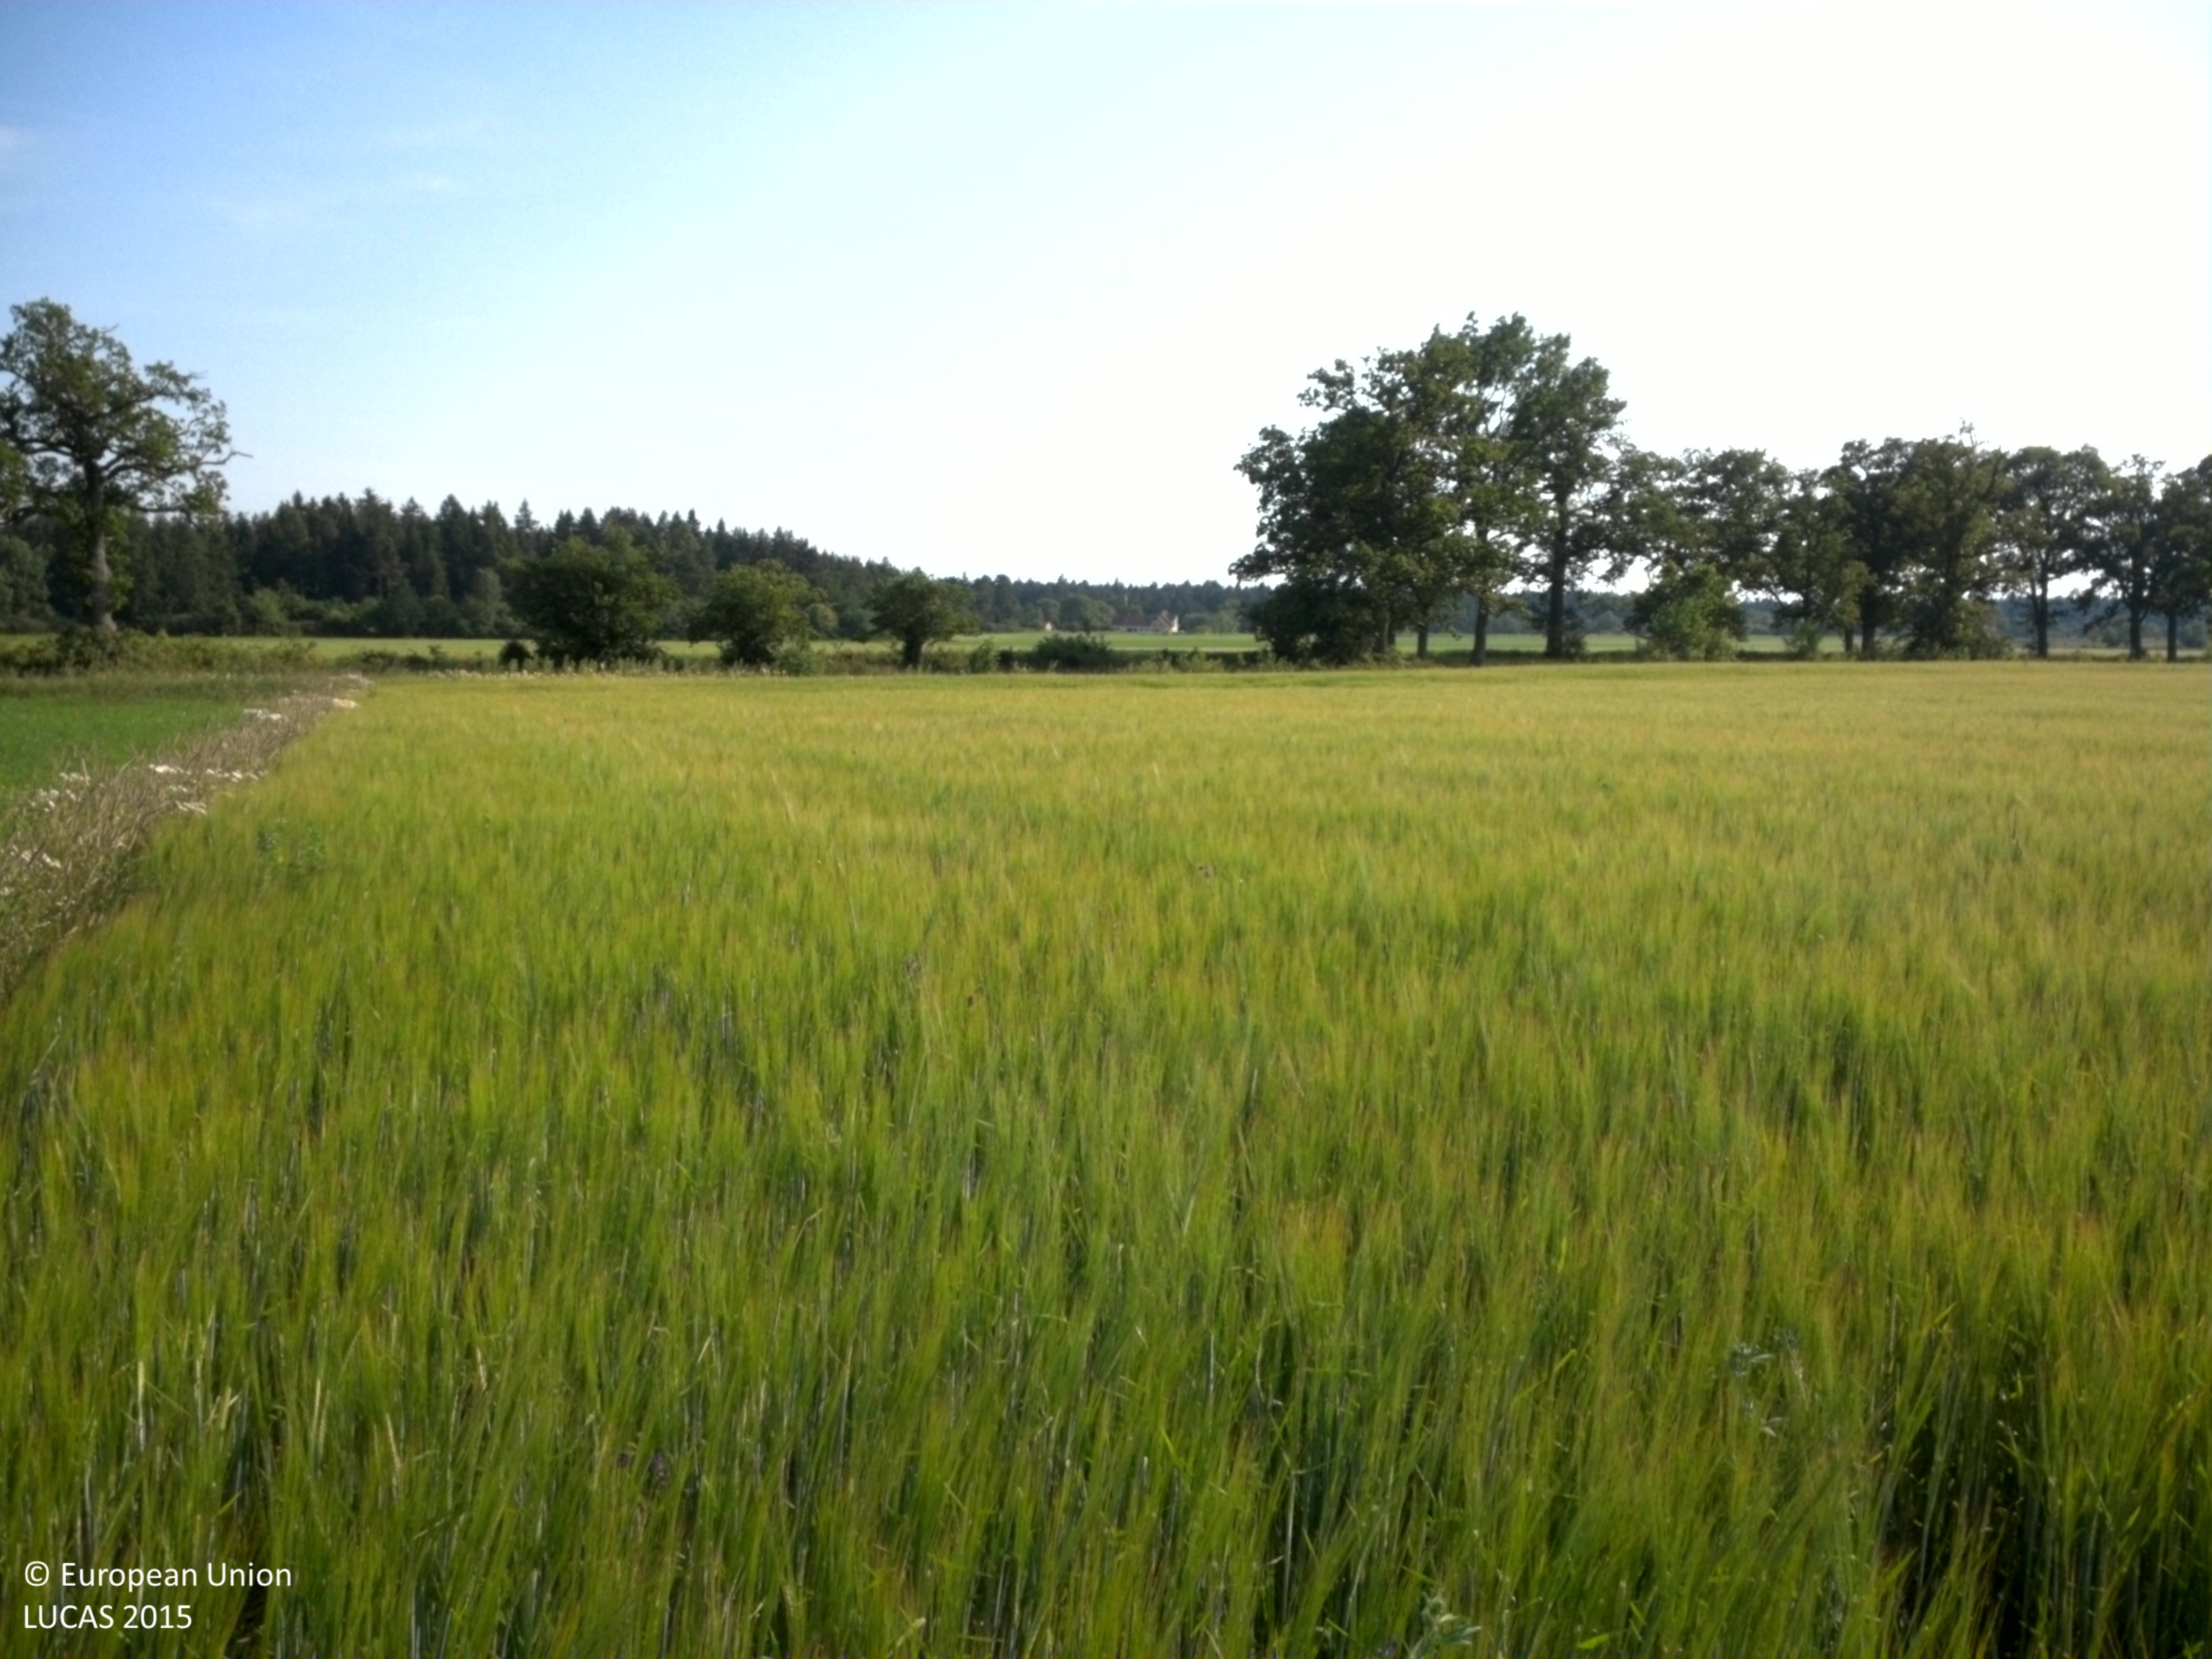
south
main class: Cropland
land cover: Barley
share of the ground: > 75 %
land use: Agriculture (excluding fallow land and kitchen gardens)
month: July
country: SE
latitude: 57.6401
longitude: 18.5349
